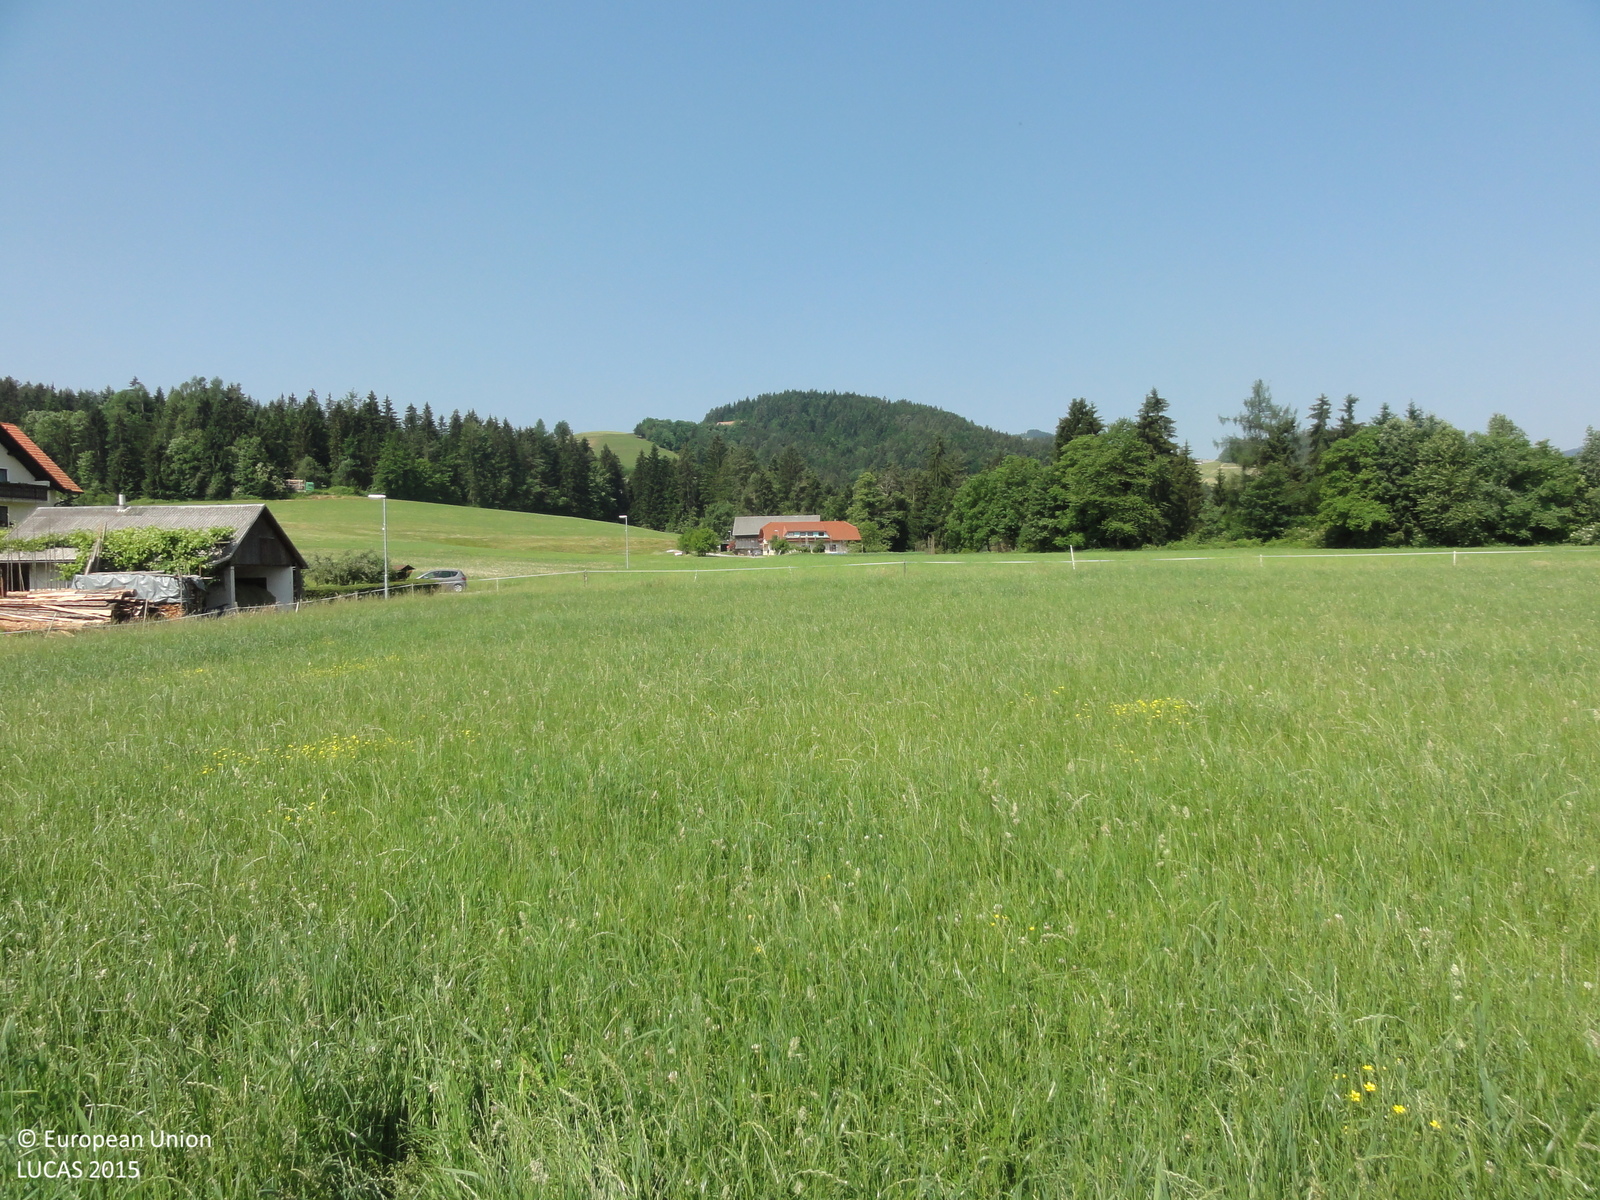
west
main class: Grassland
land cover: Grassland without tree/shrub cover
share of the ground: > 75 %
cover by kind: herbaceous plants 100 %
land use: Agriculture (excluding fallow land and kitchen gardens)
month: June
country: SI
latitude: 46.5892
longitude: 15.1275
